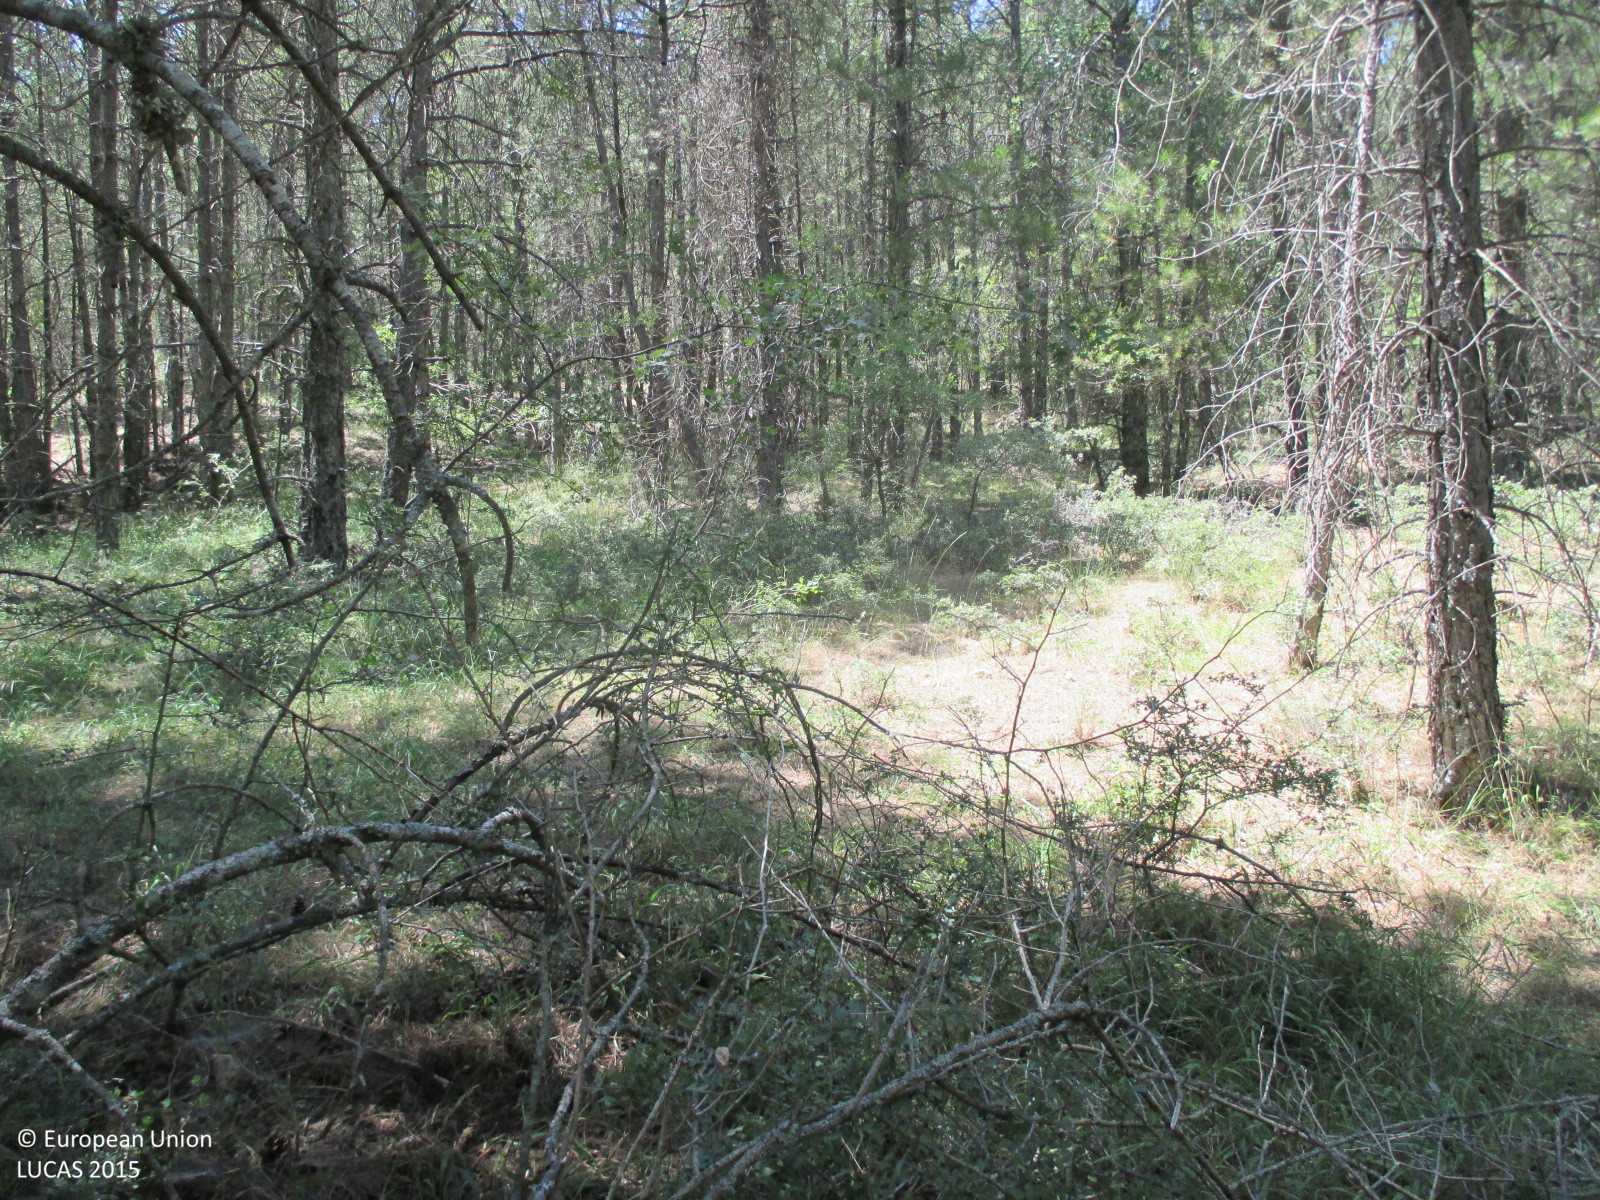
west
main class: Woodland
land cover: Pine dominated coniferous woodland
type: coniferous forest of the mediterranean region
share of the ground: > 75 %
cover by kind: coniferous forest trees 90 %, shrubs 5 %, herbaceous plants 5 %
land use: Forestry
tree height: > 5 m
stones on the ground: < 10 %
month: July
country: ES
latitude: 38.3032
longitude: -2.5643
